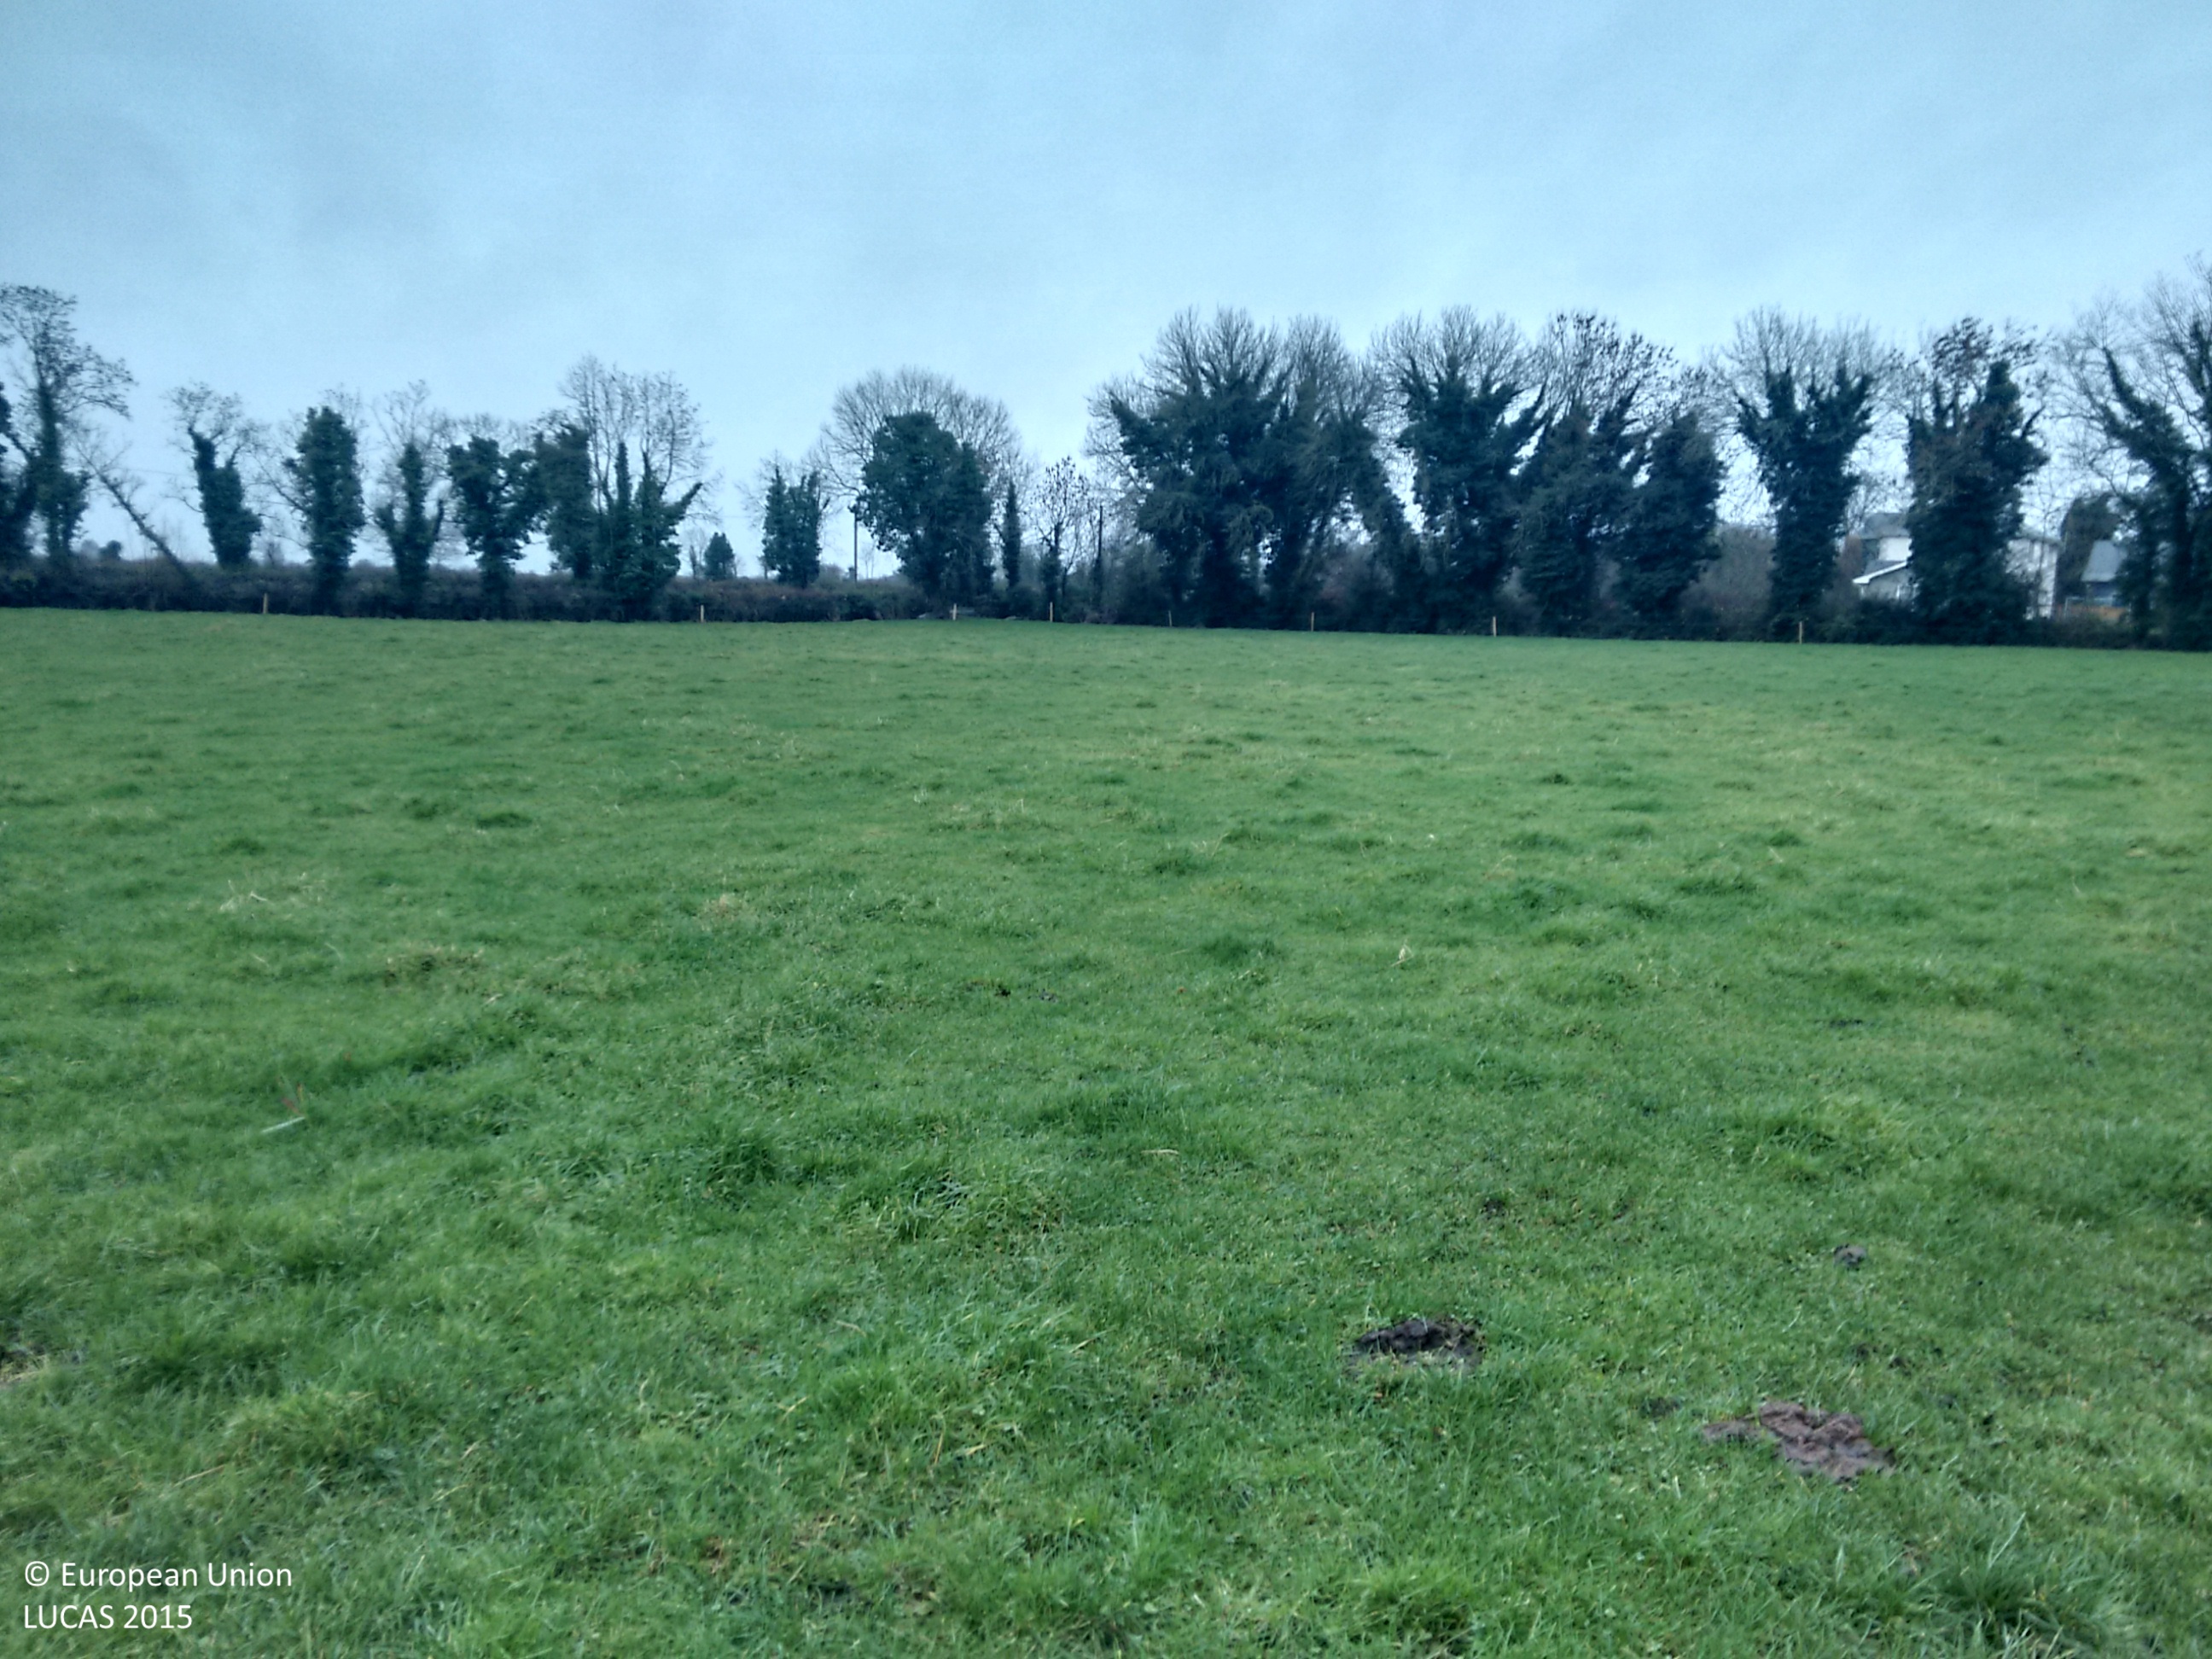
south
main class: Grassland
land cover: Grassland without tree/shrub cover
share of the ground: > 75 %
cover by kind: herbaceous plants 100 %
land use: Agriculture (excluding fallow land and kitchen gardens)
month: December
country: IE
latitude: 53.5847
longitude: -7.8900
